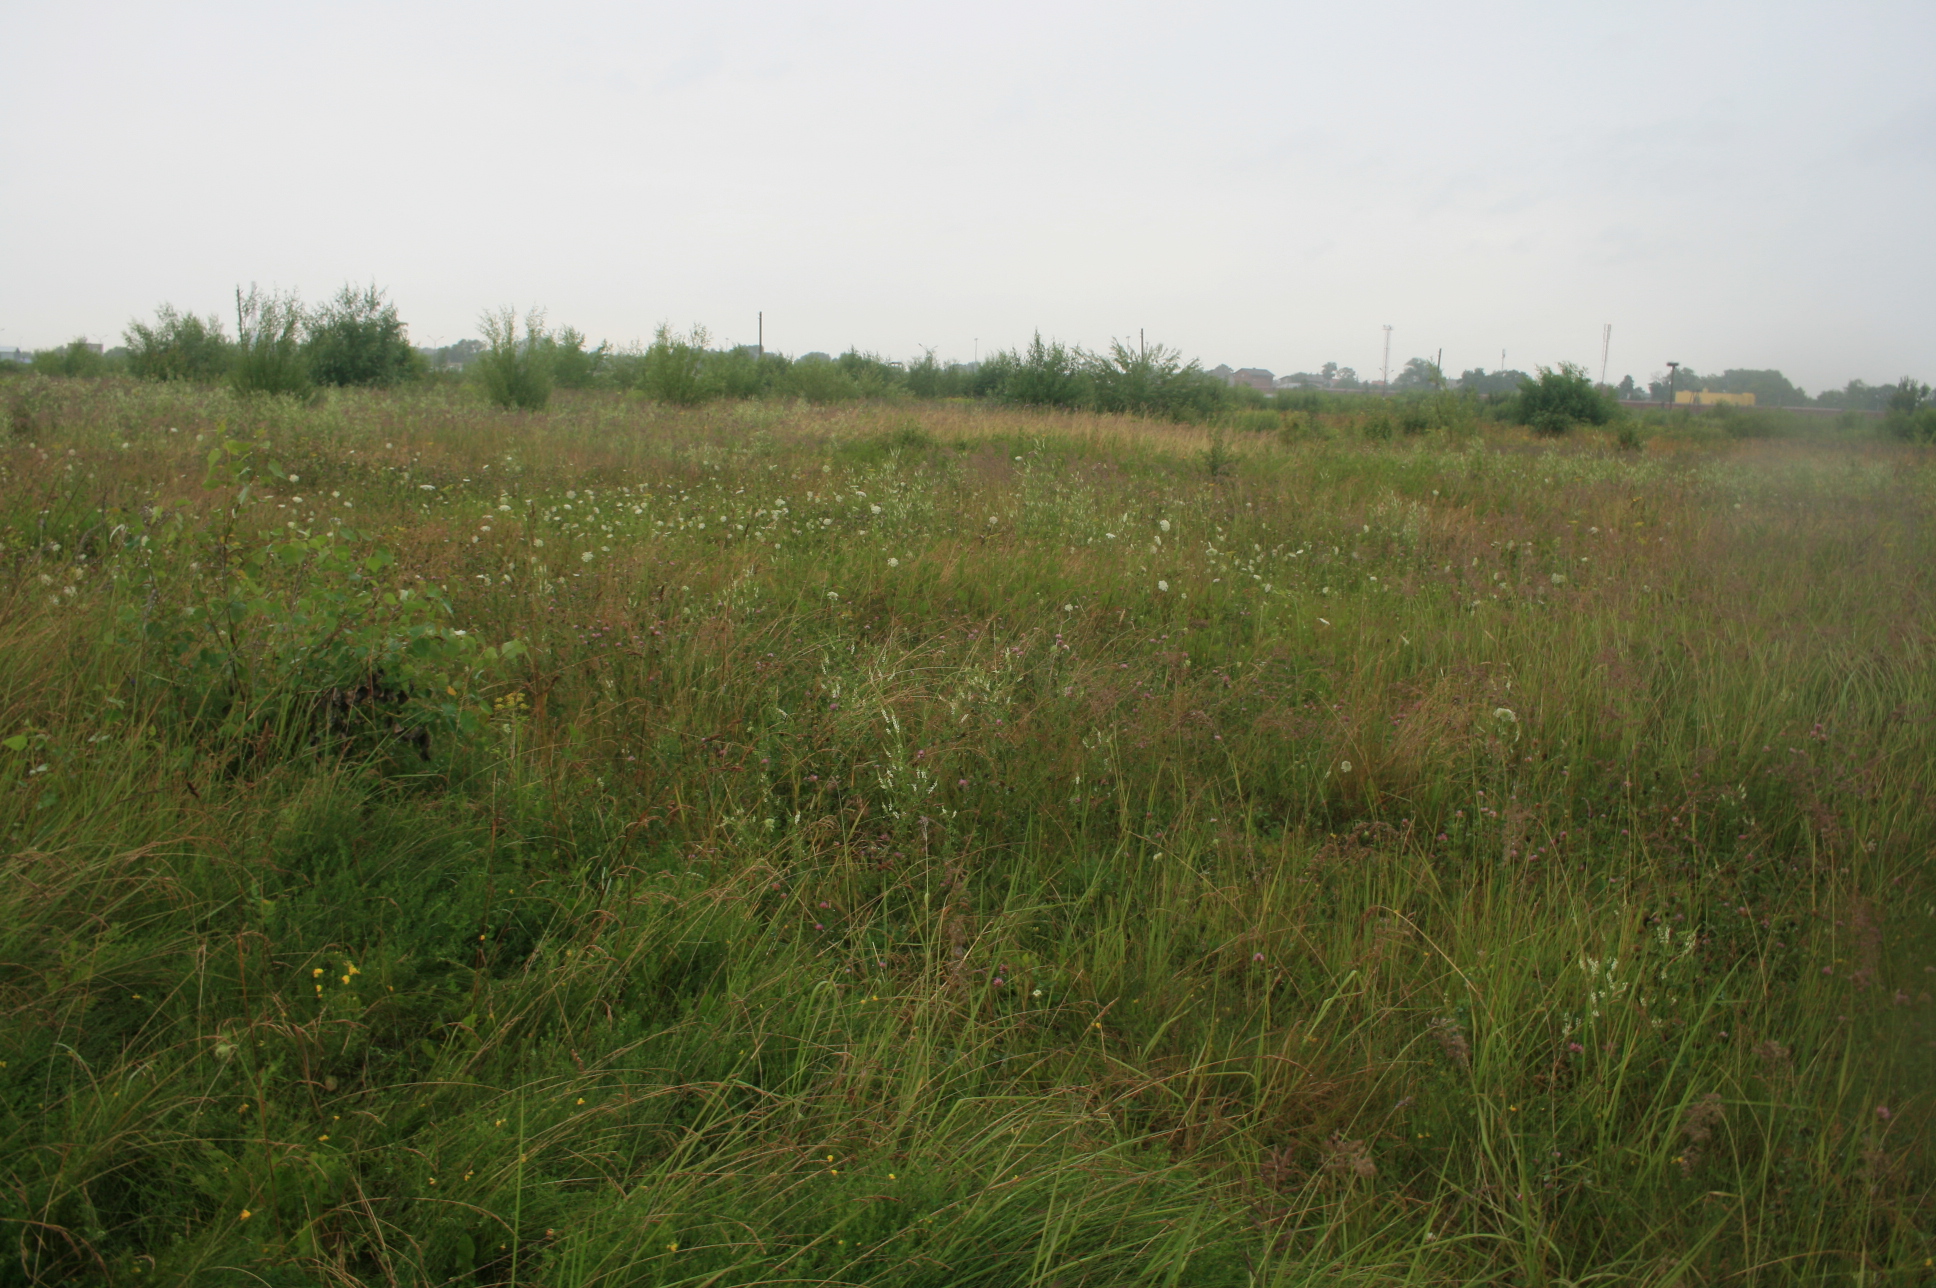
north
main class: Grassland
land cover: Grassland with sparse tree/shrub cover
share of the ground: > 75 %
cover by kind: herbaceous plants 90 %, broadleaved forest trees 5 %, shrubs 5 %
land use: Semi-natural and natural areas not in use
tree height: < 5 m
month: July
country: LT
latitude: 55.6581
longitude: 21.2153
